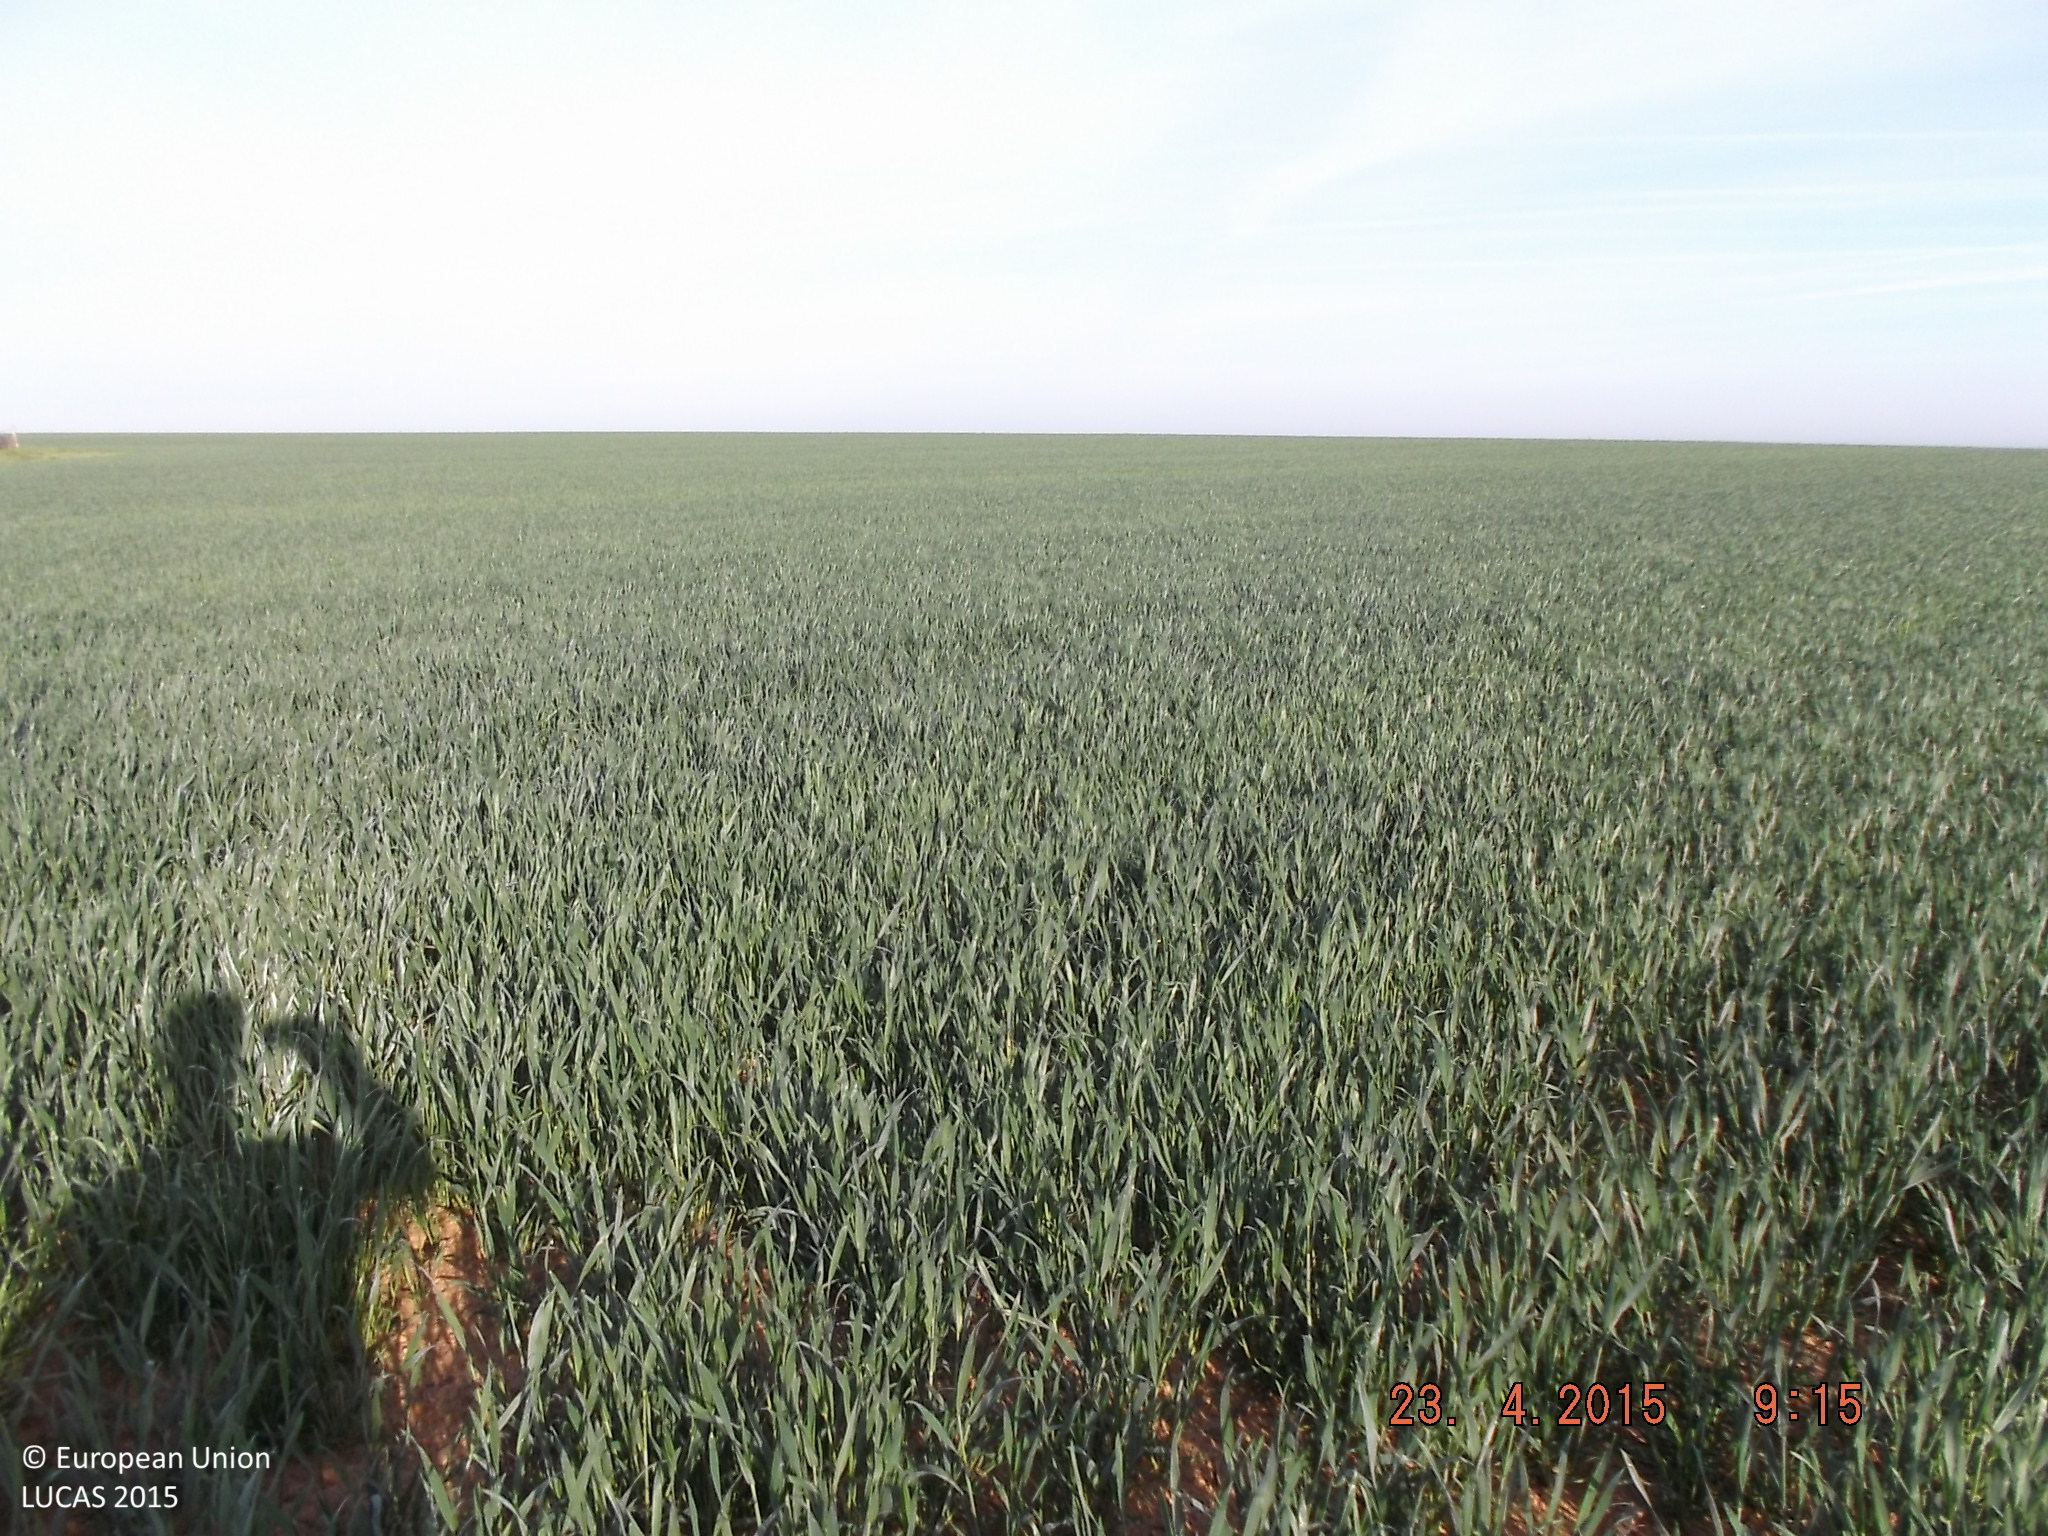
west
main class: Cropland
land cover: Common wheat
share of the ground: > 75 %
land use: Agriculture (excluding fallow land and kitchen gardens)
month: April
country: ES
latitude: 40.9135
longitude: -5.8838
